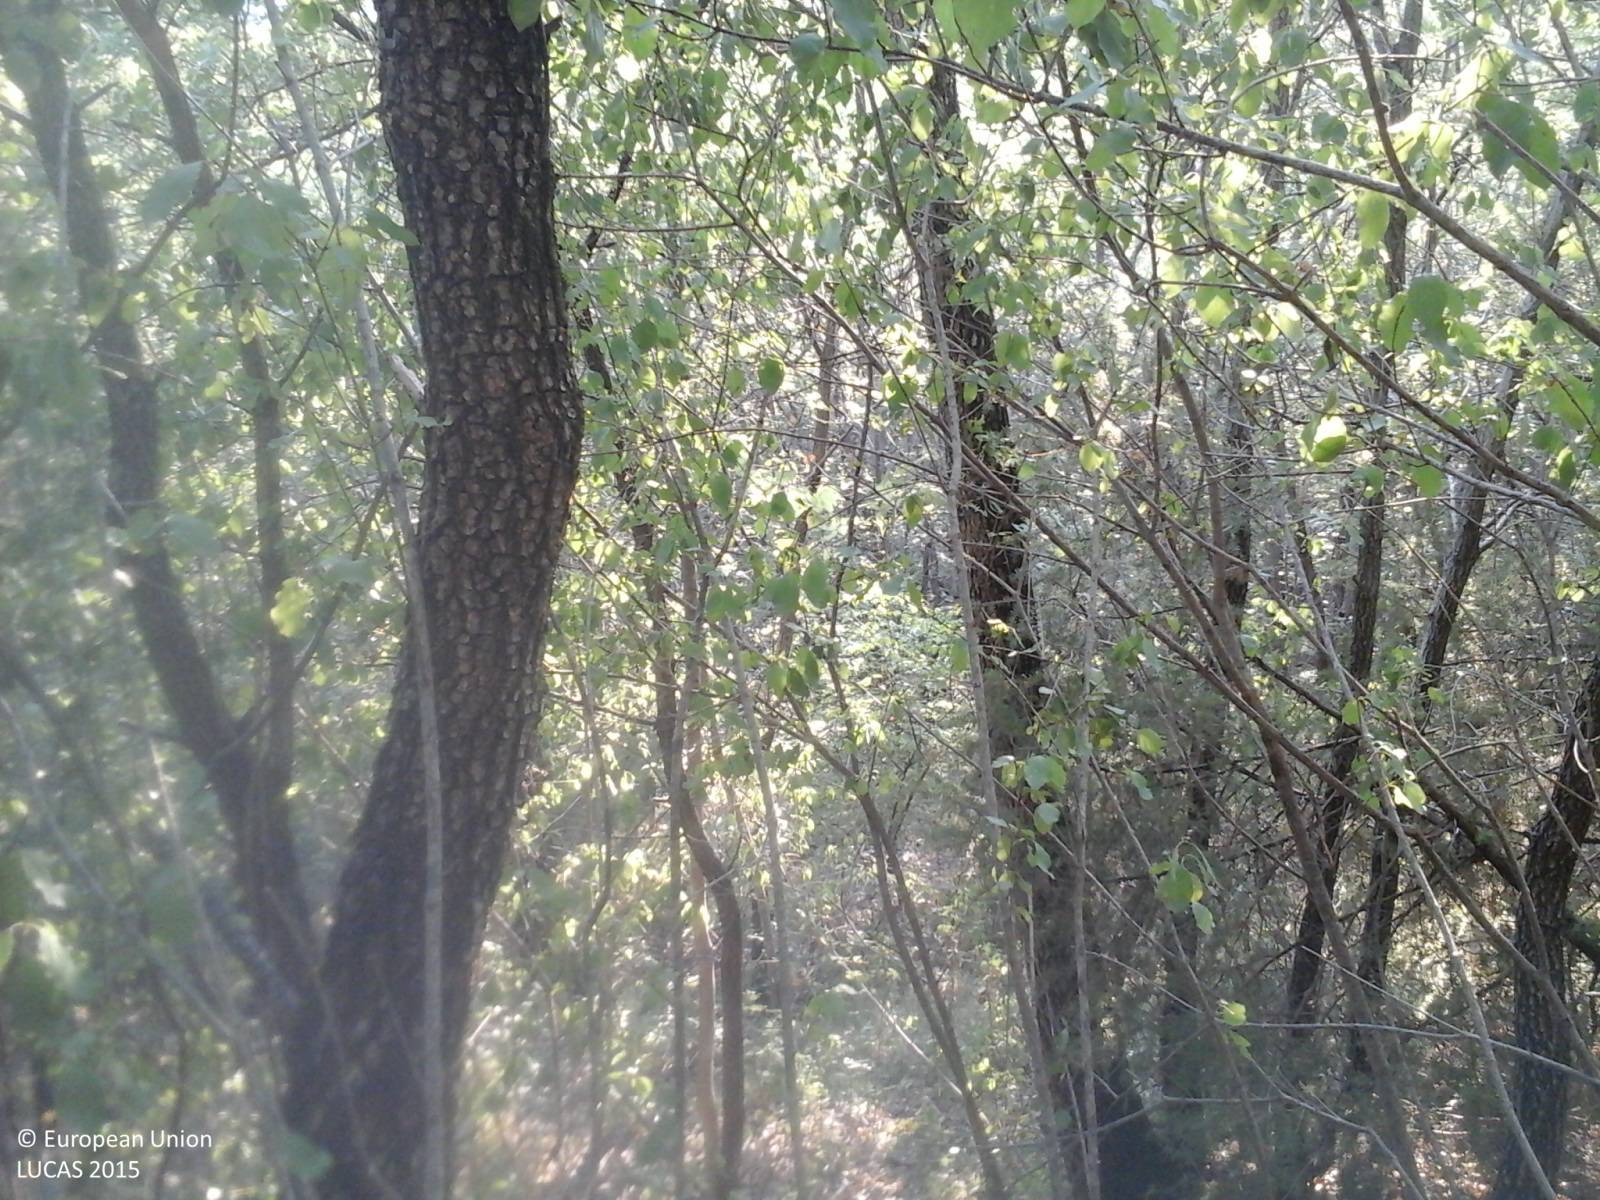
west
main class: Woodland
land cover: Broadleaved woodland
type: thermophilous deciduous forest
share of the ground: > 75 %
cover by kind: broadleaved forest trees 90 %, shrubs 10 %
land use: Forestry
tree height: > 5 m
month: August
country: IT
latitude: 43.5574
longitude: 11.8890
